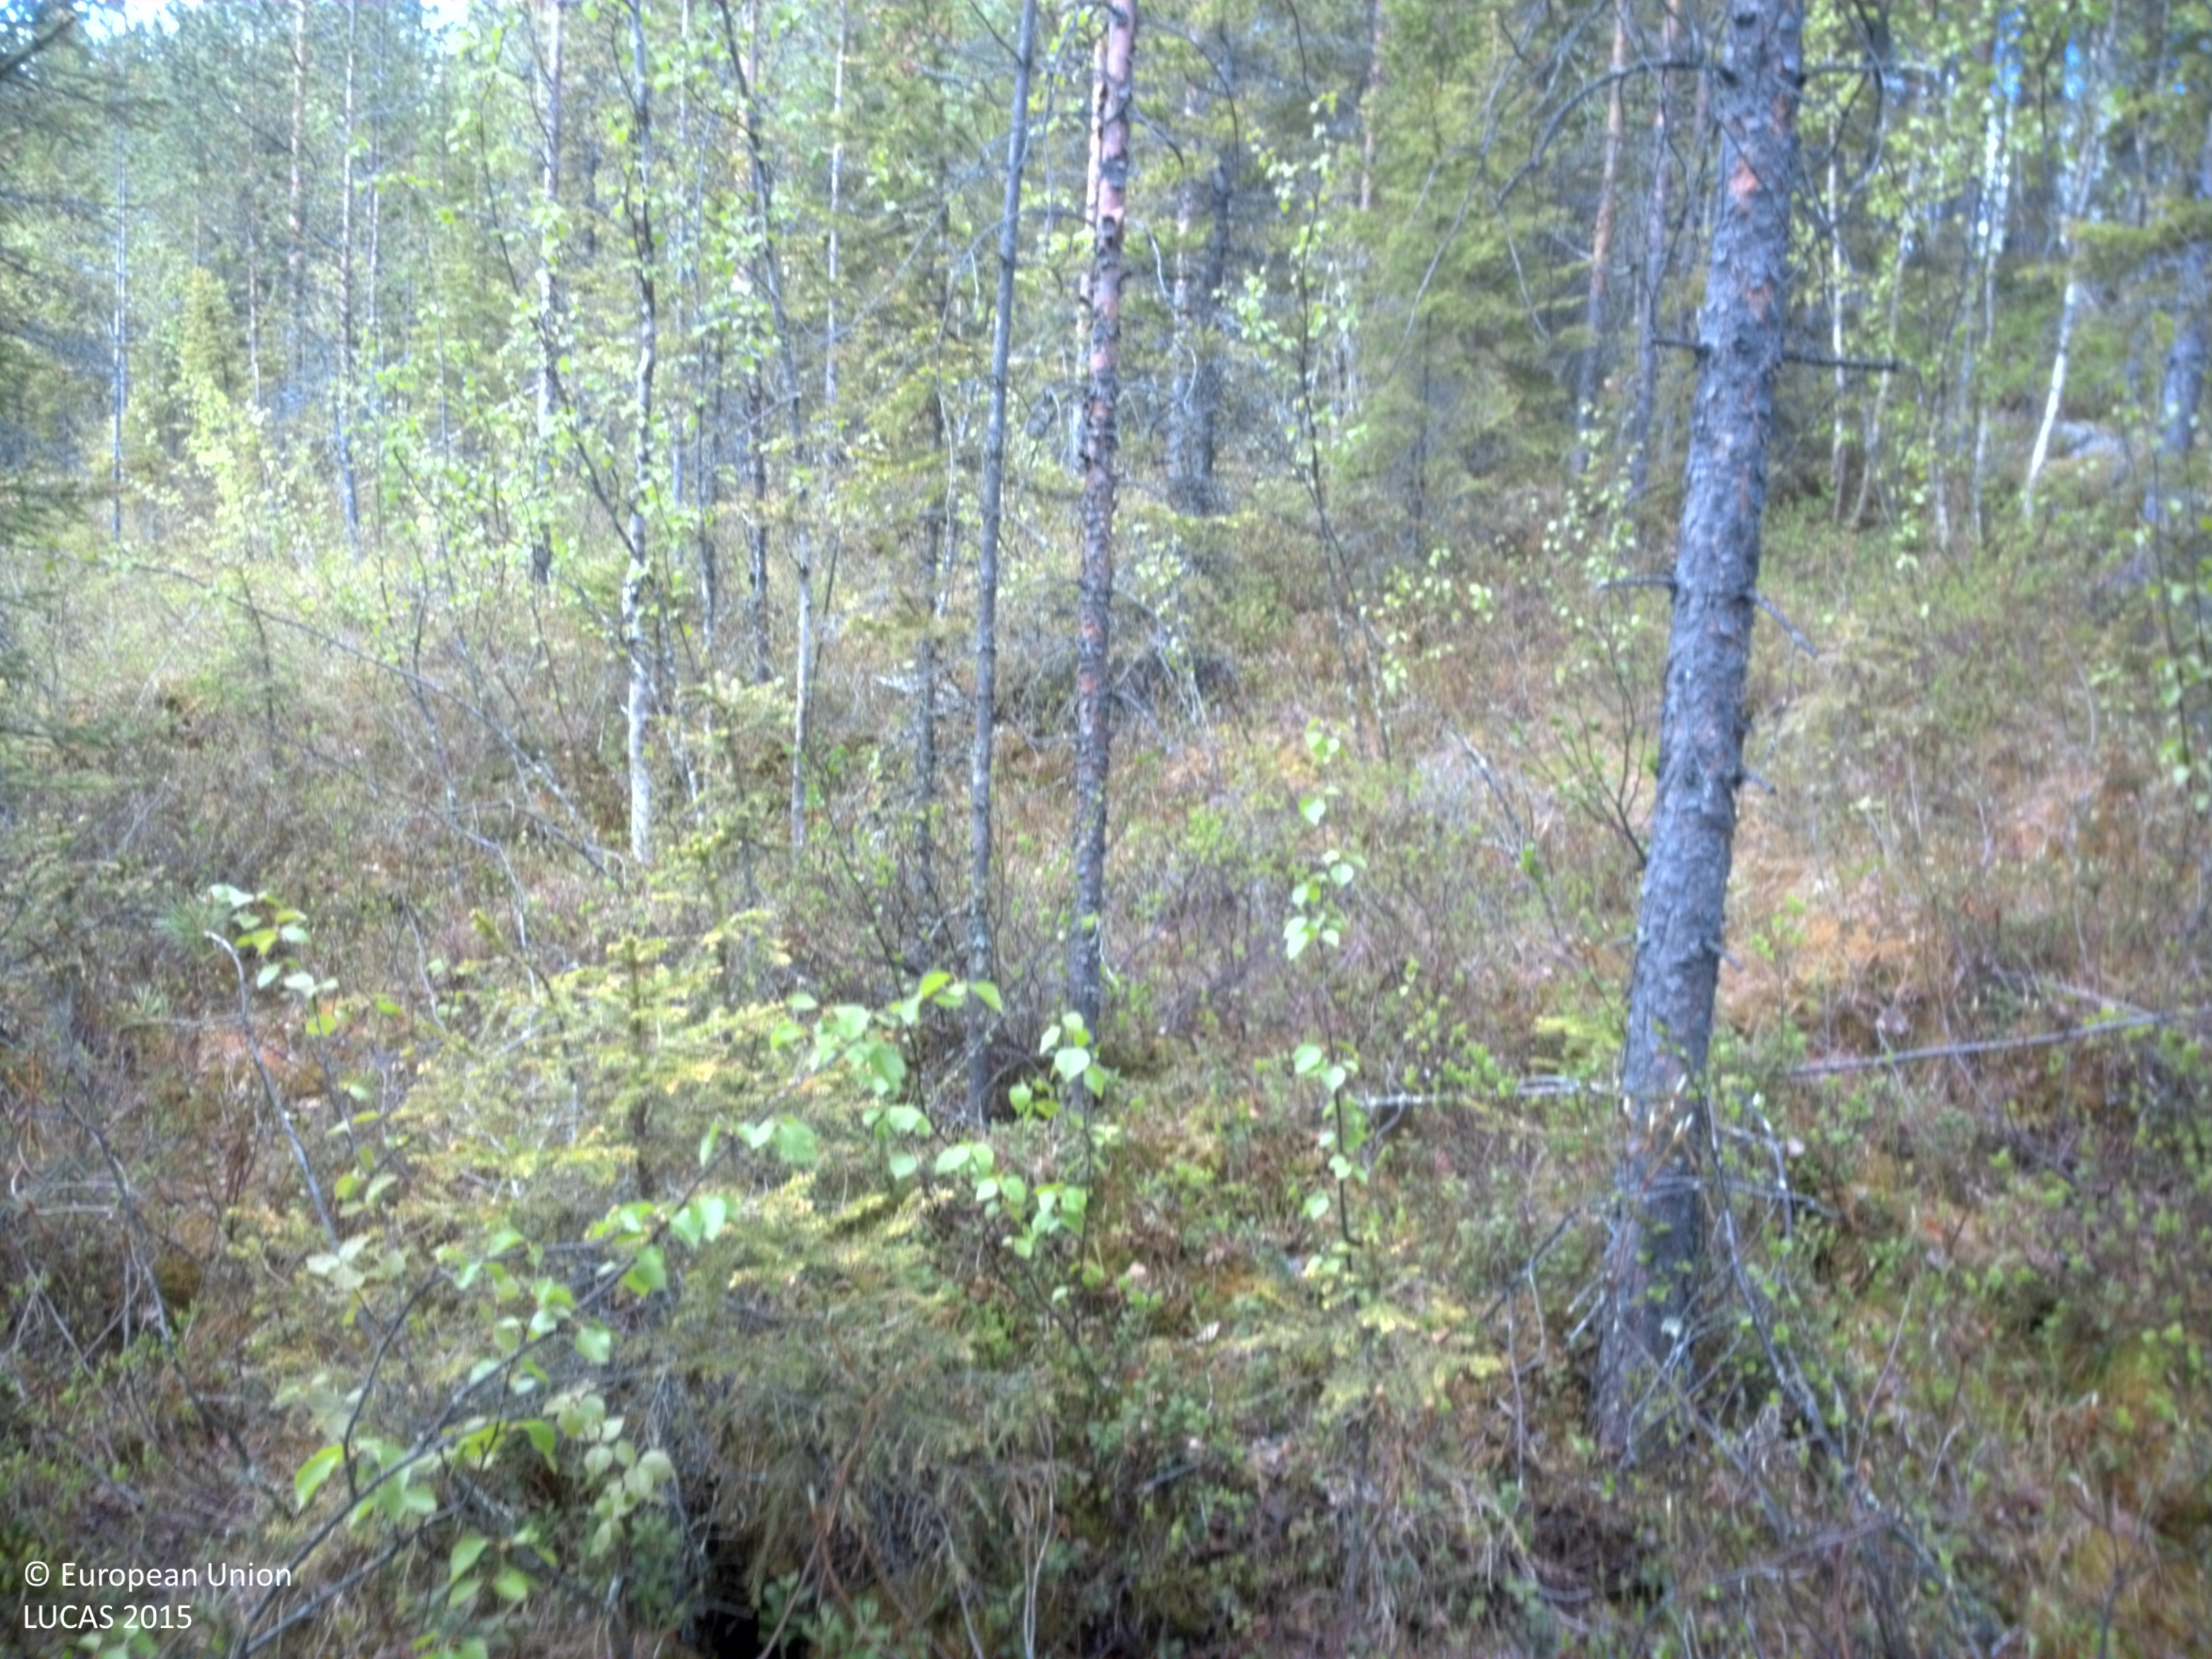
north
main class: Woodland
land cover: Other mixed woodland
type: boreal forest
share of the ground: 50 - 75 %
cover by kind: coniferous forest trees 35 %, shrubs 30 %, broadleaved forest trees 15 %, herbaceous plants 15 %, lichens and mosses 5 %
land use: Forestry
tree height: > 5 m
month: June
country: SE
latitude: 66.7515
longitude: 21.9274
